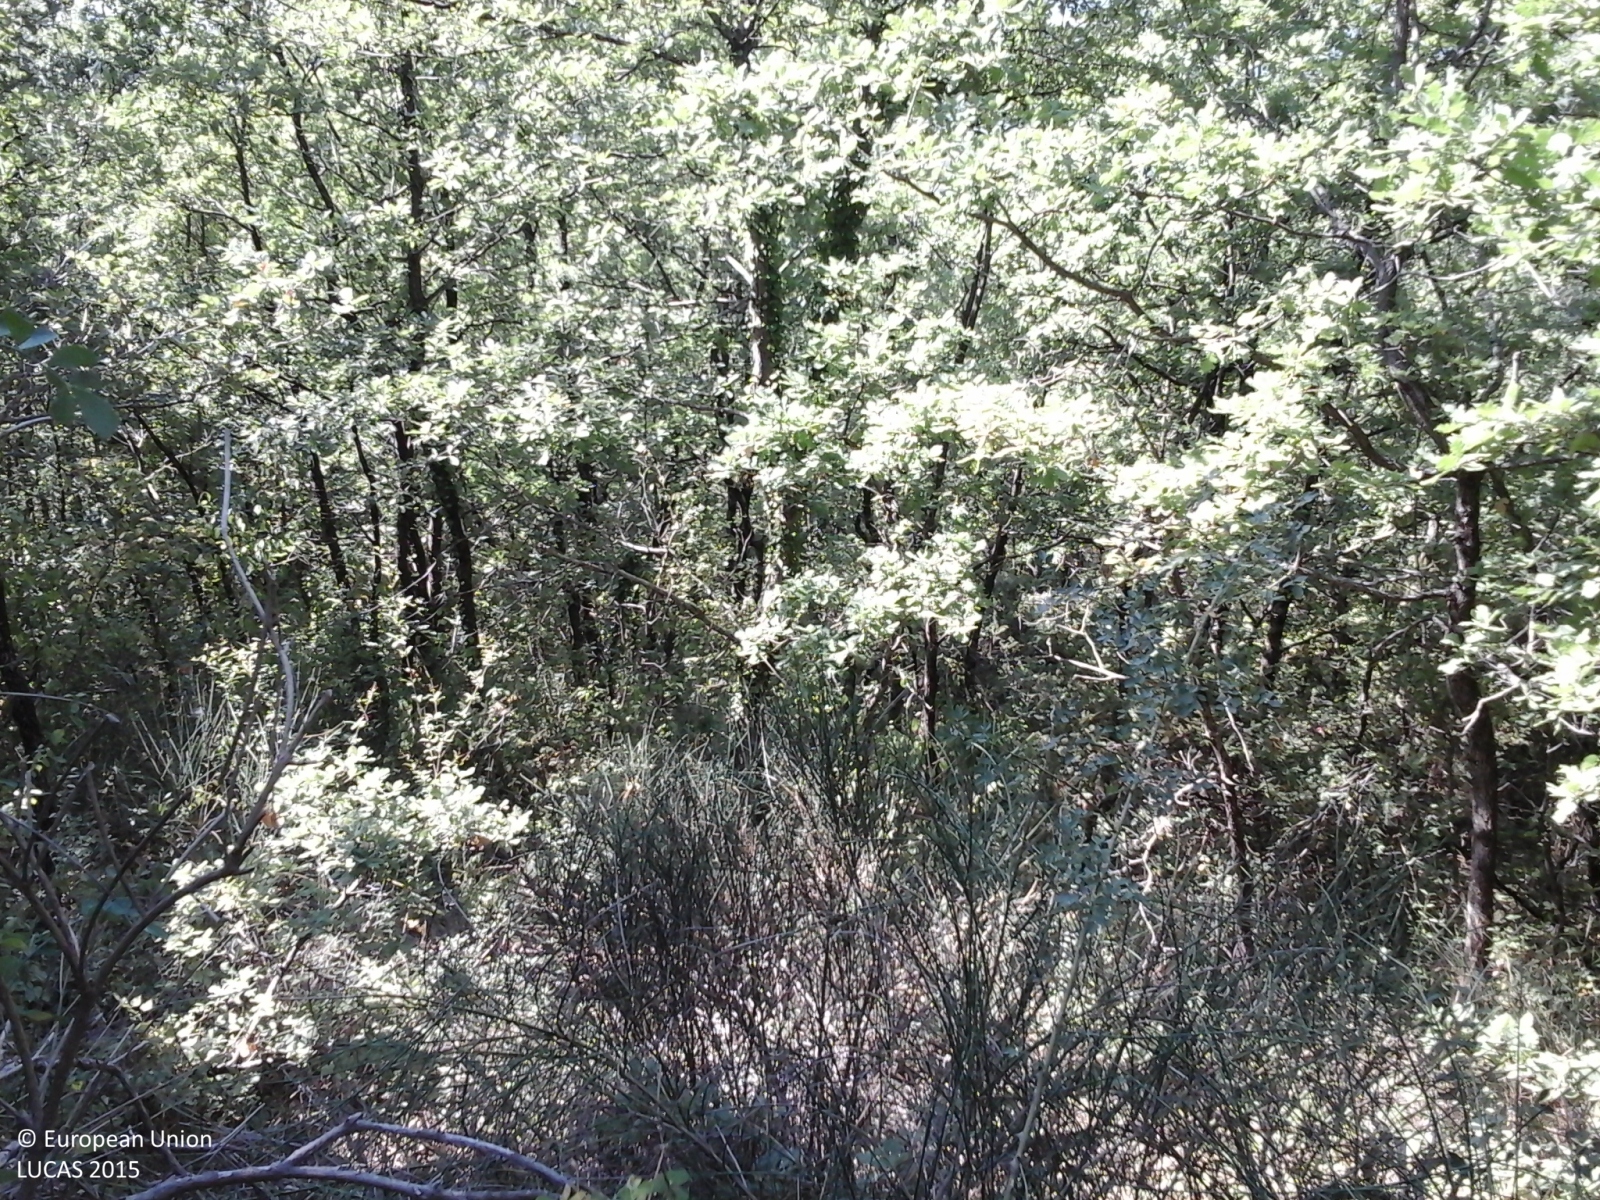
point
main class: Woodland
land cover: Broadleaved woodland
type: thermophilous deciduous forest
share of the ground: > 75 %
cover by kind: broadleaved forest trees 85 %, shrubs 10 %, herbaceous plants 5 %
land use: Forestry
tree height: > 5 m
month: September
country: IT
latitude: 41.6985
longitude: 14.2029
